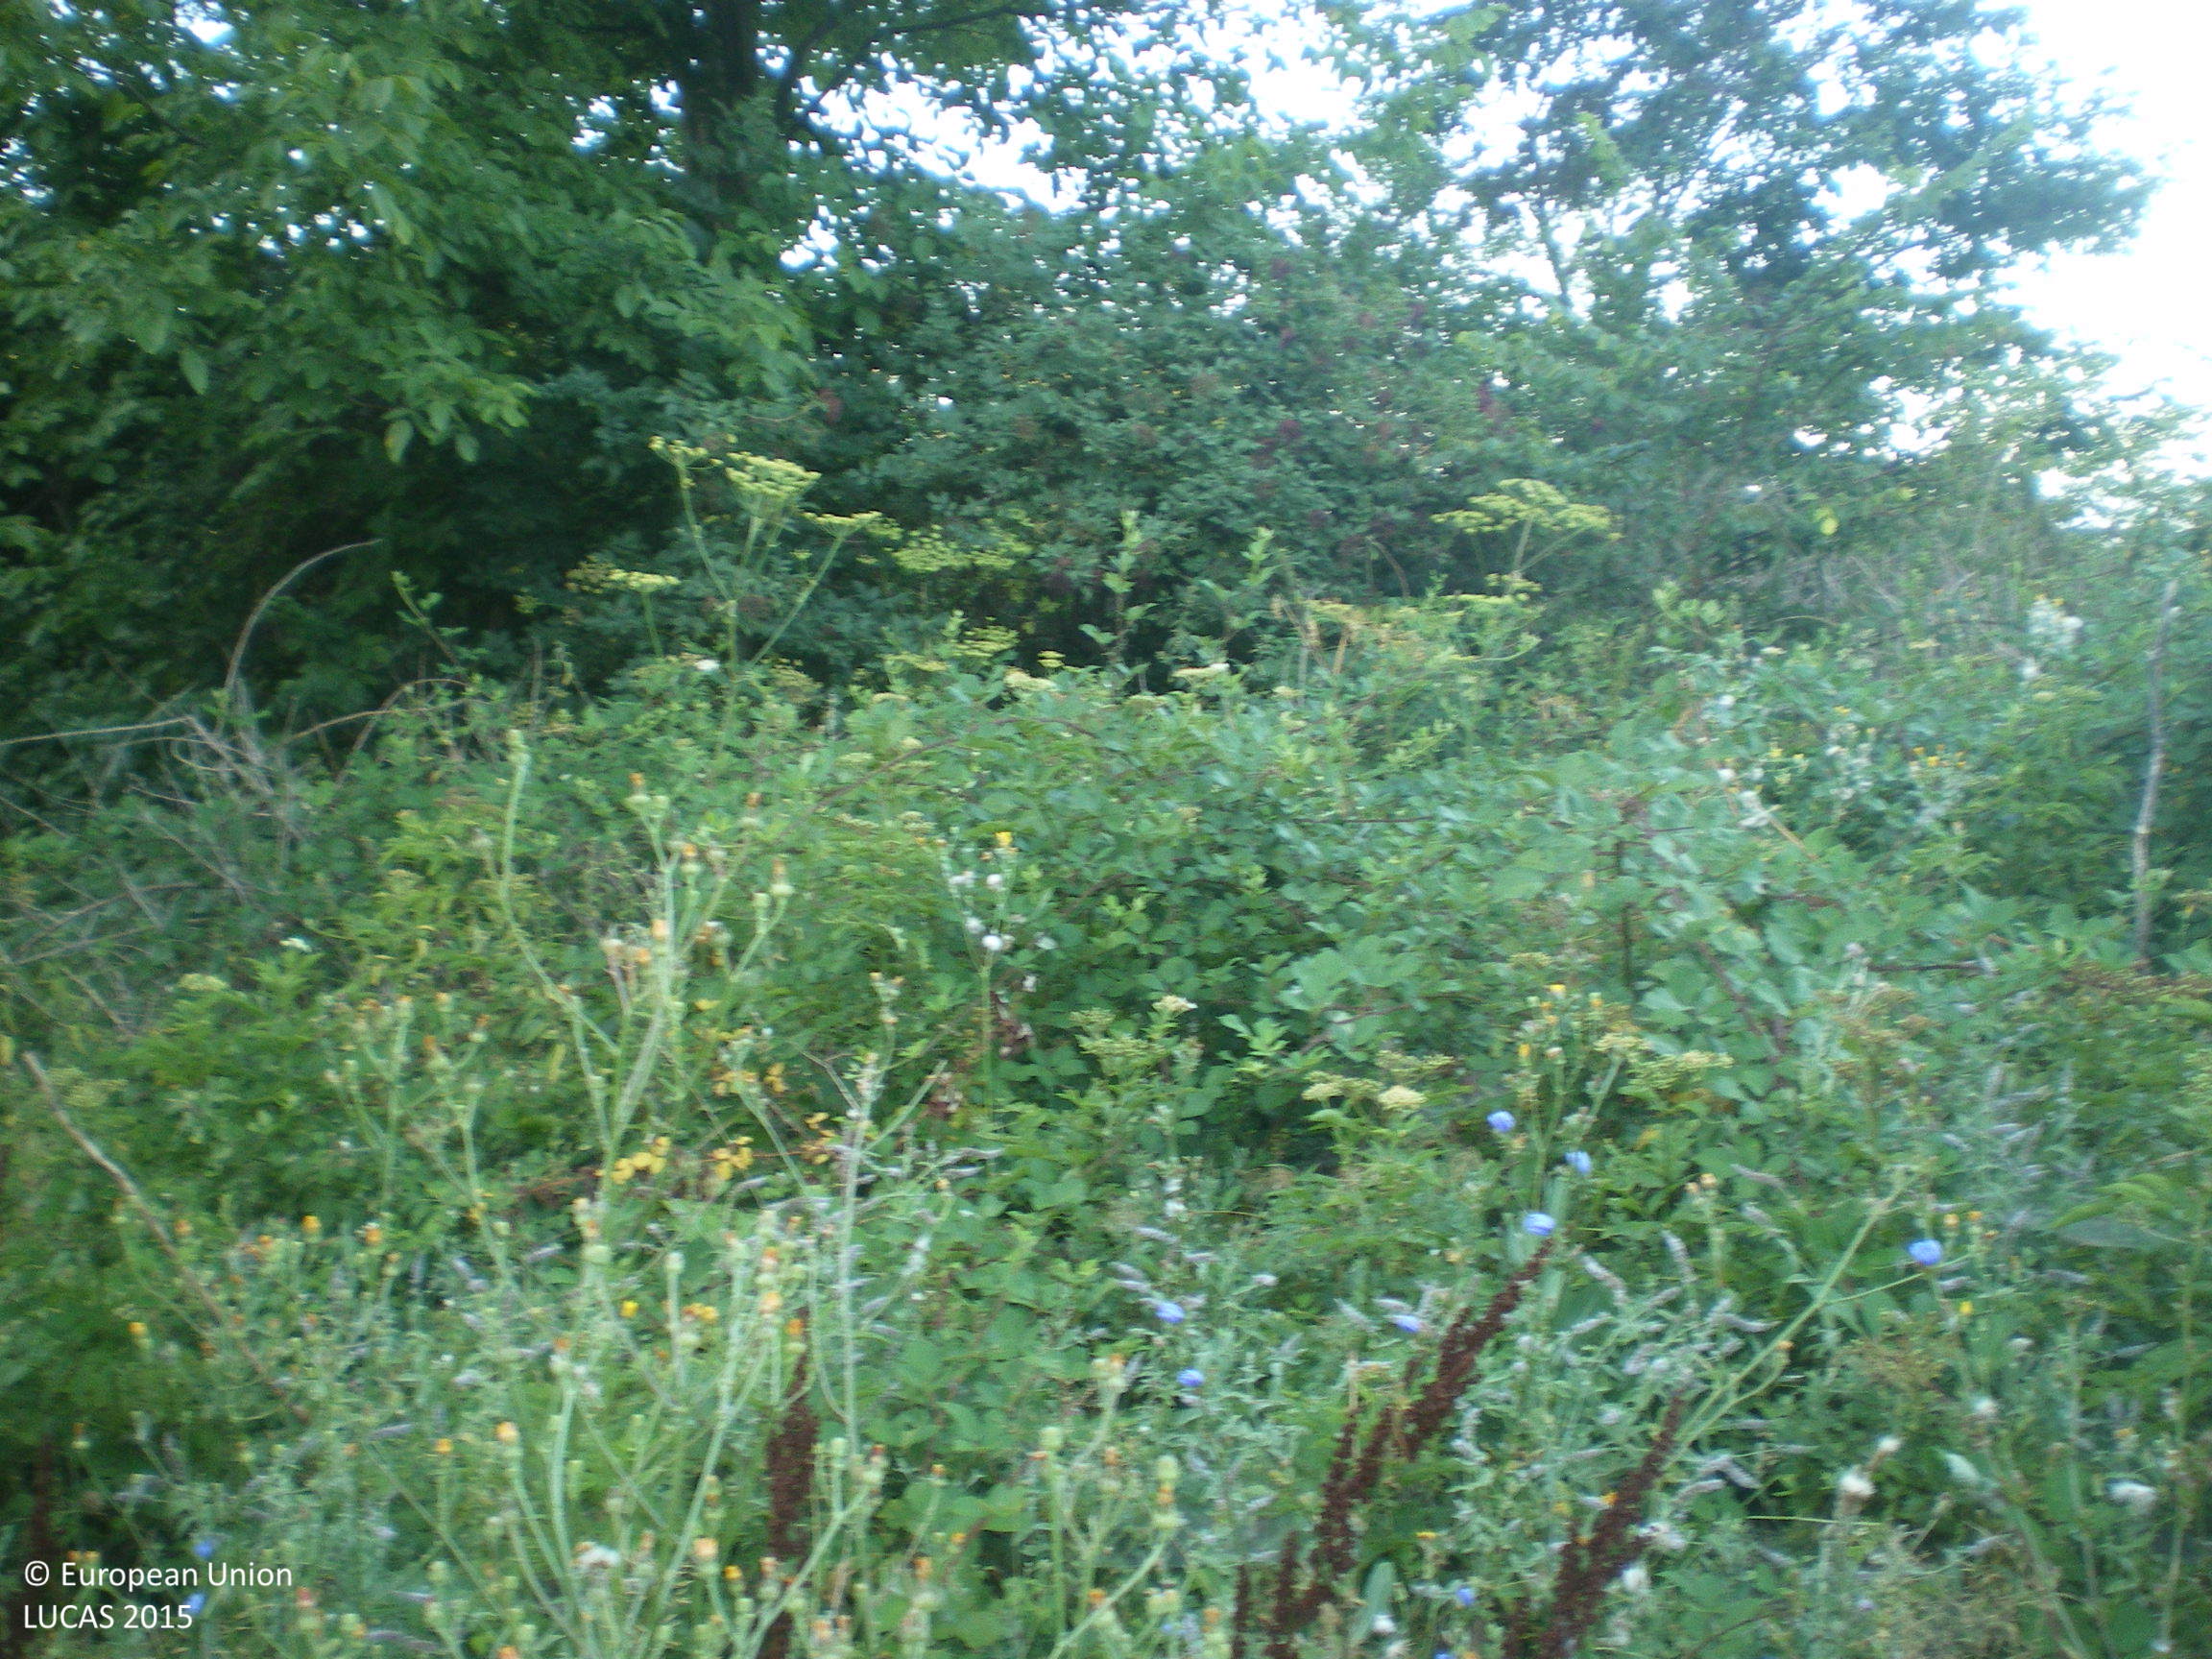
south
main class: Grassland
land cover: Spontaneously vegetated surfaces
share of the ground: > 75 %
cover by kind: herbaceous plants 100 %
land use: Agriculture (excluding fallow land and kitchen gardens)
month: July
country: BG
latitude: 42.6291
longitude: 25.2476
